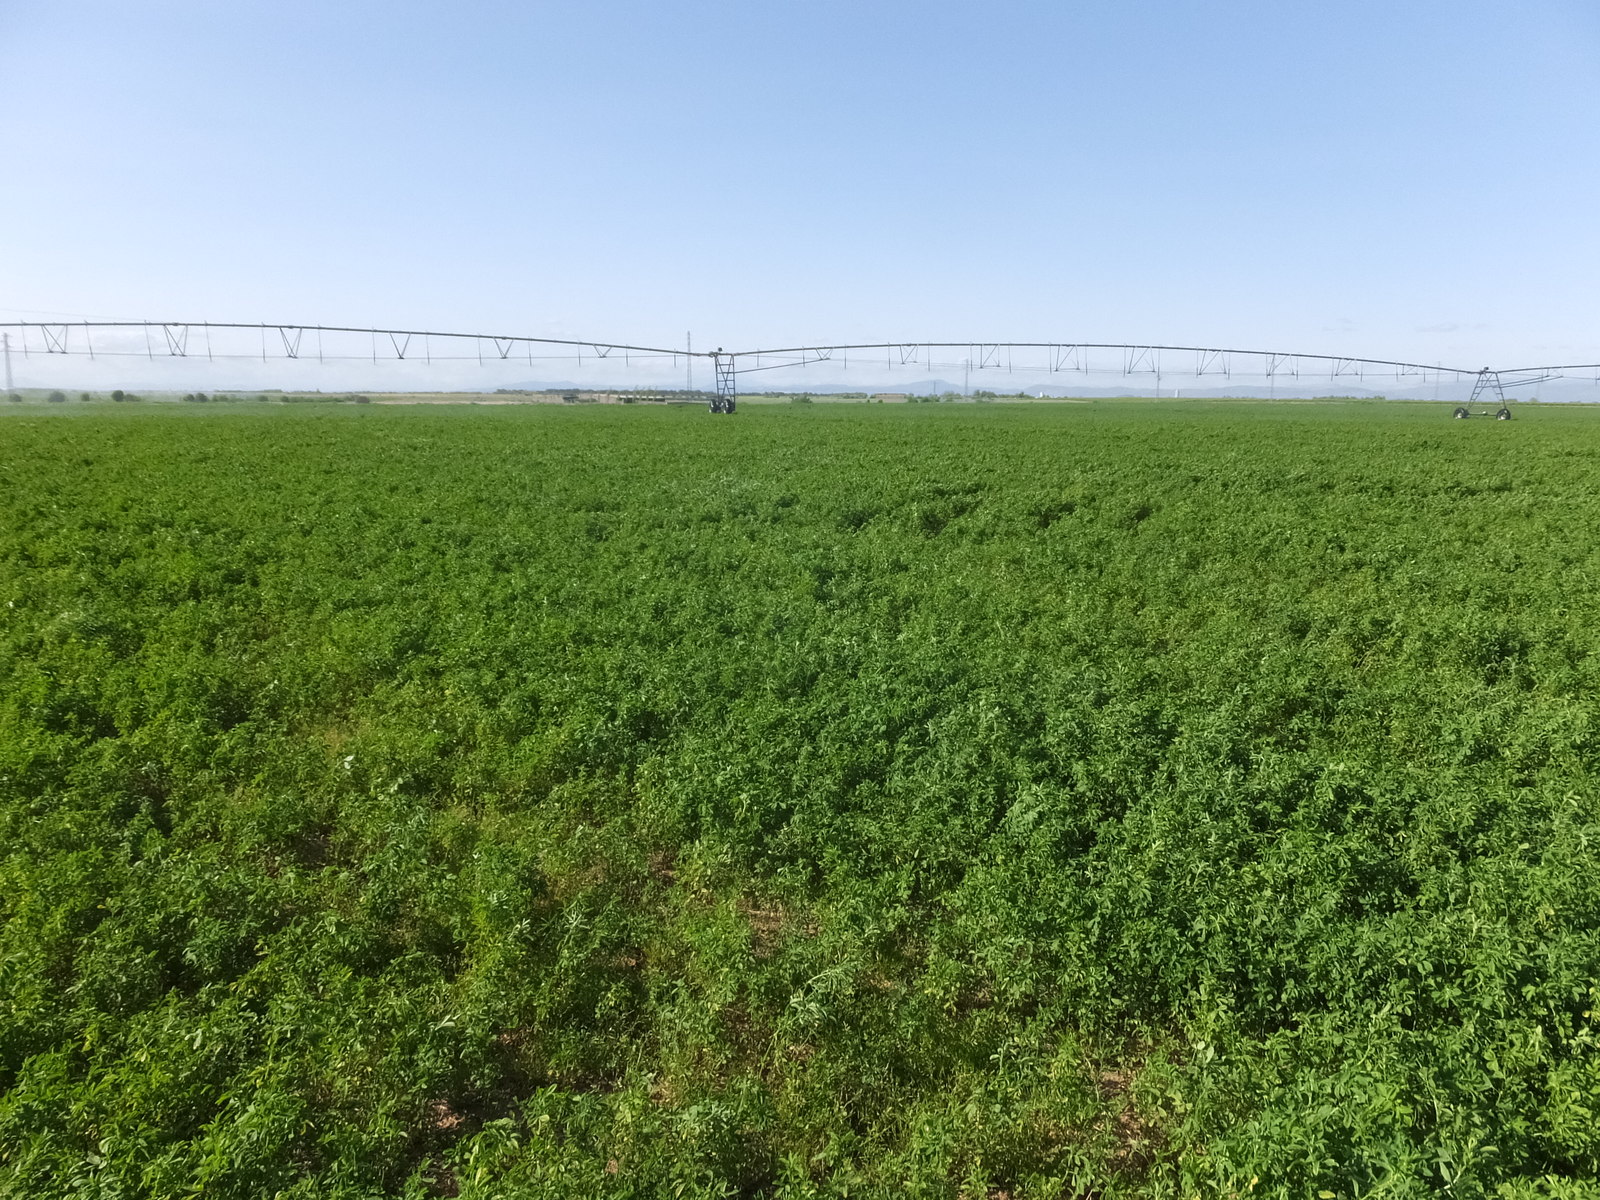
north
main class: Cropland
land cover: Lucerne
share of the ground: > 75 %
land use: Agriculture (excluding fallow land and kitchen gardens)
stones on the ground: < 10 %
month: May
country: ES
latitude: 41.6555
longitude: 0.4399
